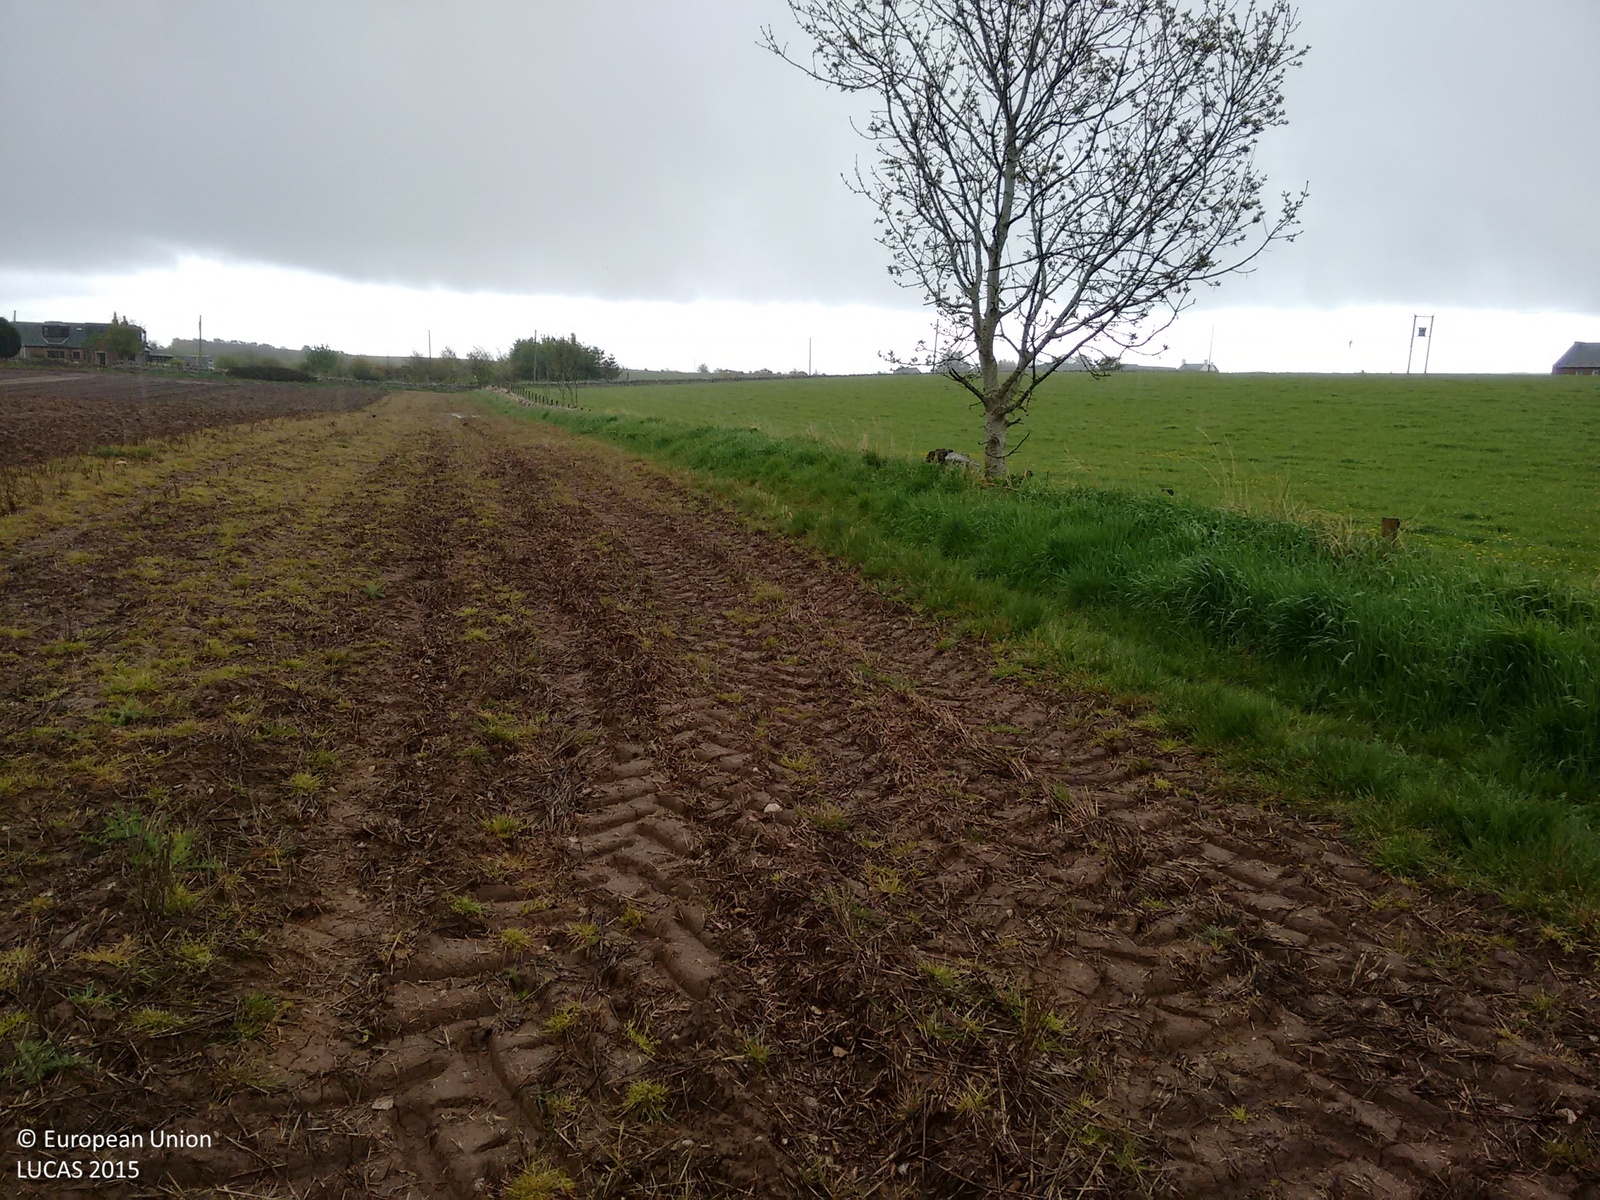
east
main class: Grassland
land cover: Spontaneously vegetated surfaces
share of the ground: 10 - 25 %
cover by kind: unconsolidated bare surface 60 %, herbaceous plants 40 %
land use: Agriculture (excluding fallow land and kitchen gardens)
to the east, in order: Spontaneously vegetated surfaces; Grass margins; Dry stone walls; Single bushes/trees; Fences; Grassland without tree/shrub cover; Electric lines; Fences; Dry stone walls; Grass margins; Paved roads, cycling and walking lanes; Grass margins; Dry stone walls; Electric lines; Grass margins; Barley
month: May
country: GB
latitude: 56.6070
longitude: -2.5531
